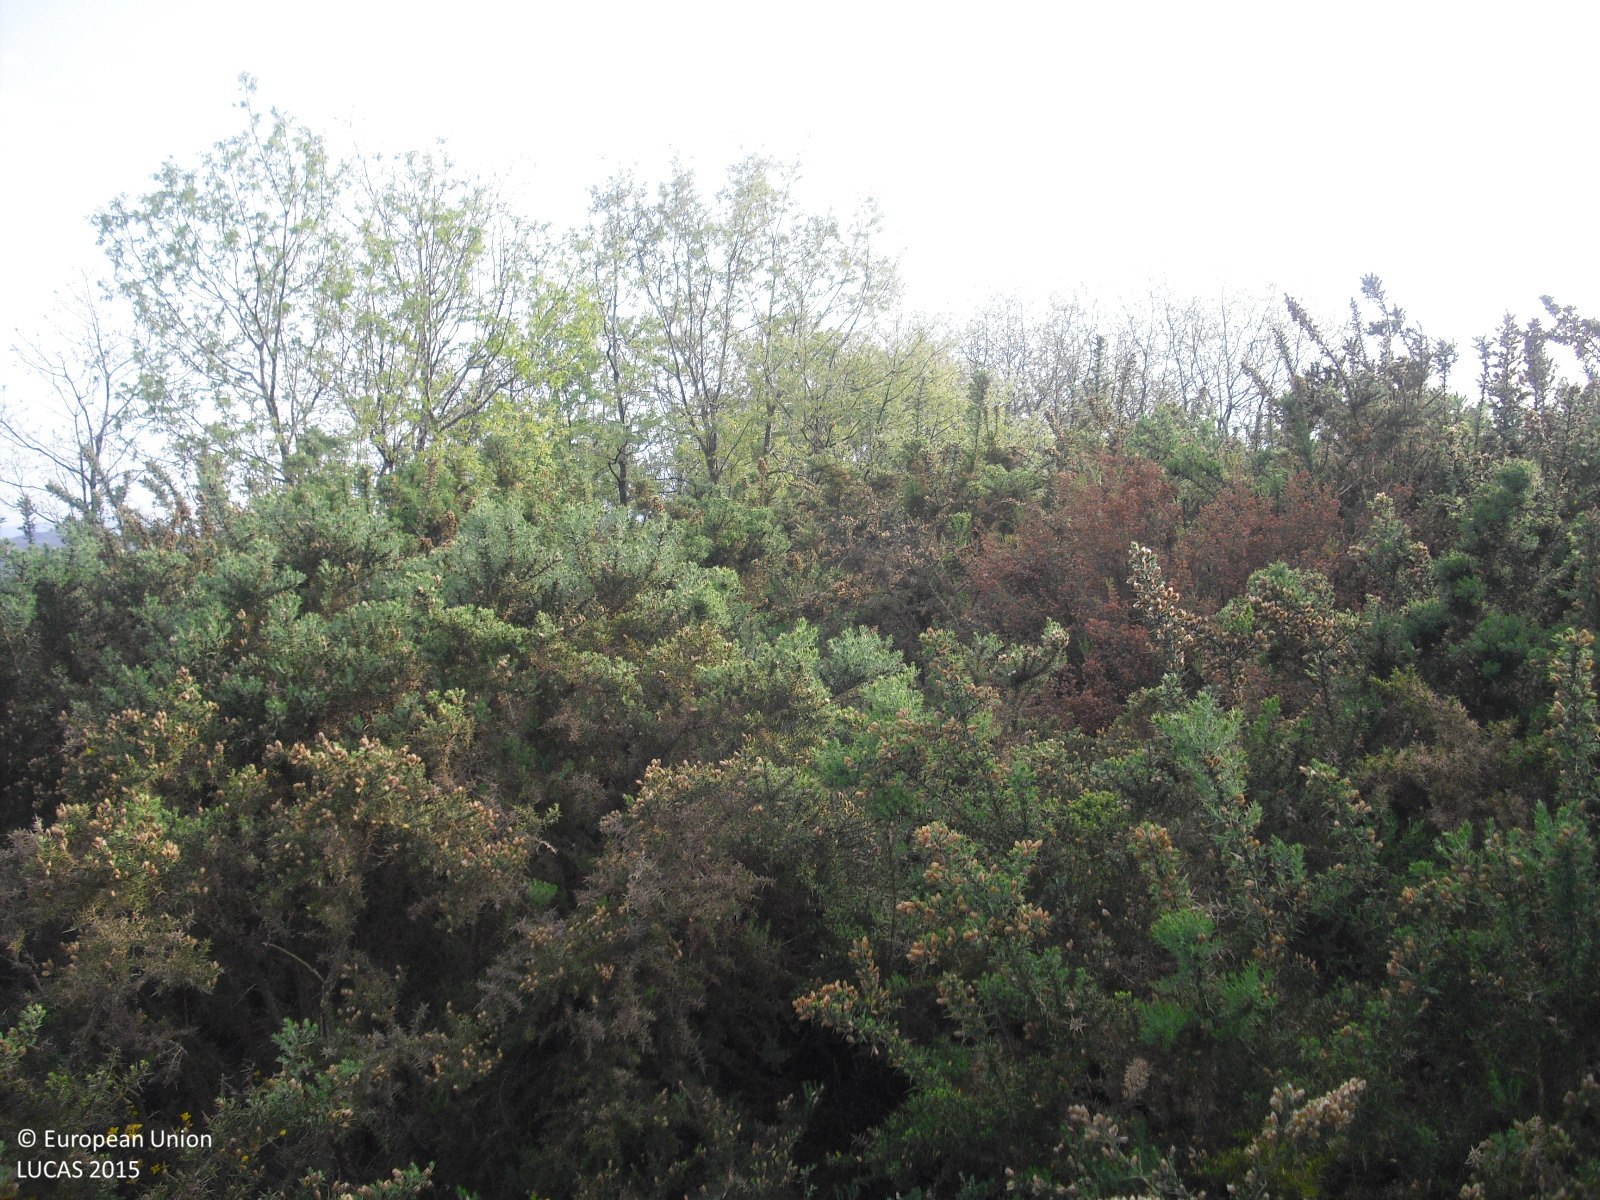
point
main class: Shrubland
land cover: Shrubland with sparse tree cover
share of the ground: > 75 %
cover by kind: shrubs 95 %, broadleaved forest trees 5 %
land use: Semi-natural and natural areas not in use
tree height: < 5 m
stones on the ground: 10 - 25 %
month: May
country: ES
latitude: 42.1668
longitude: -7.6070
